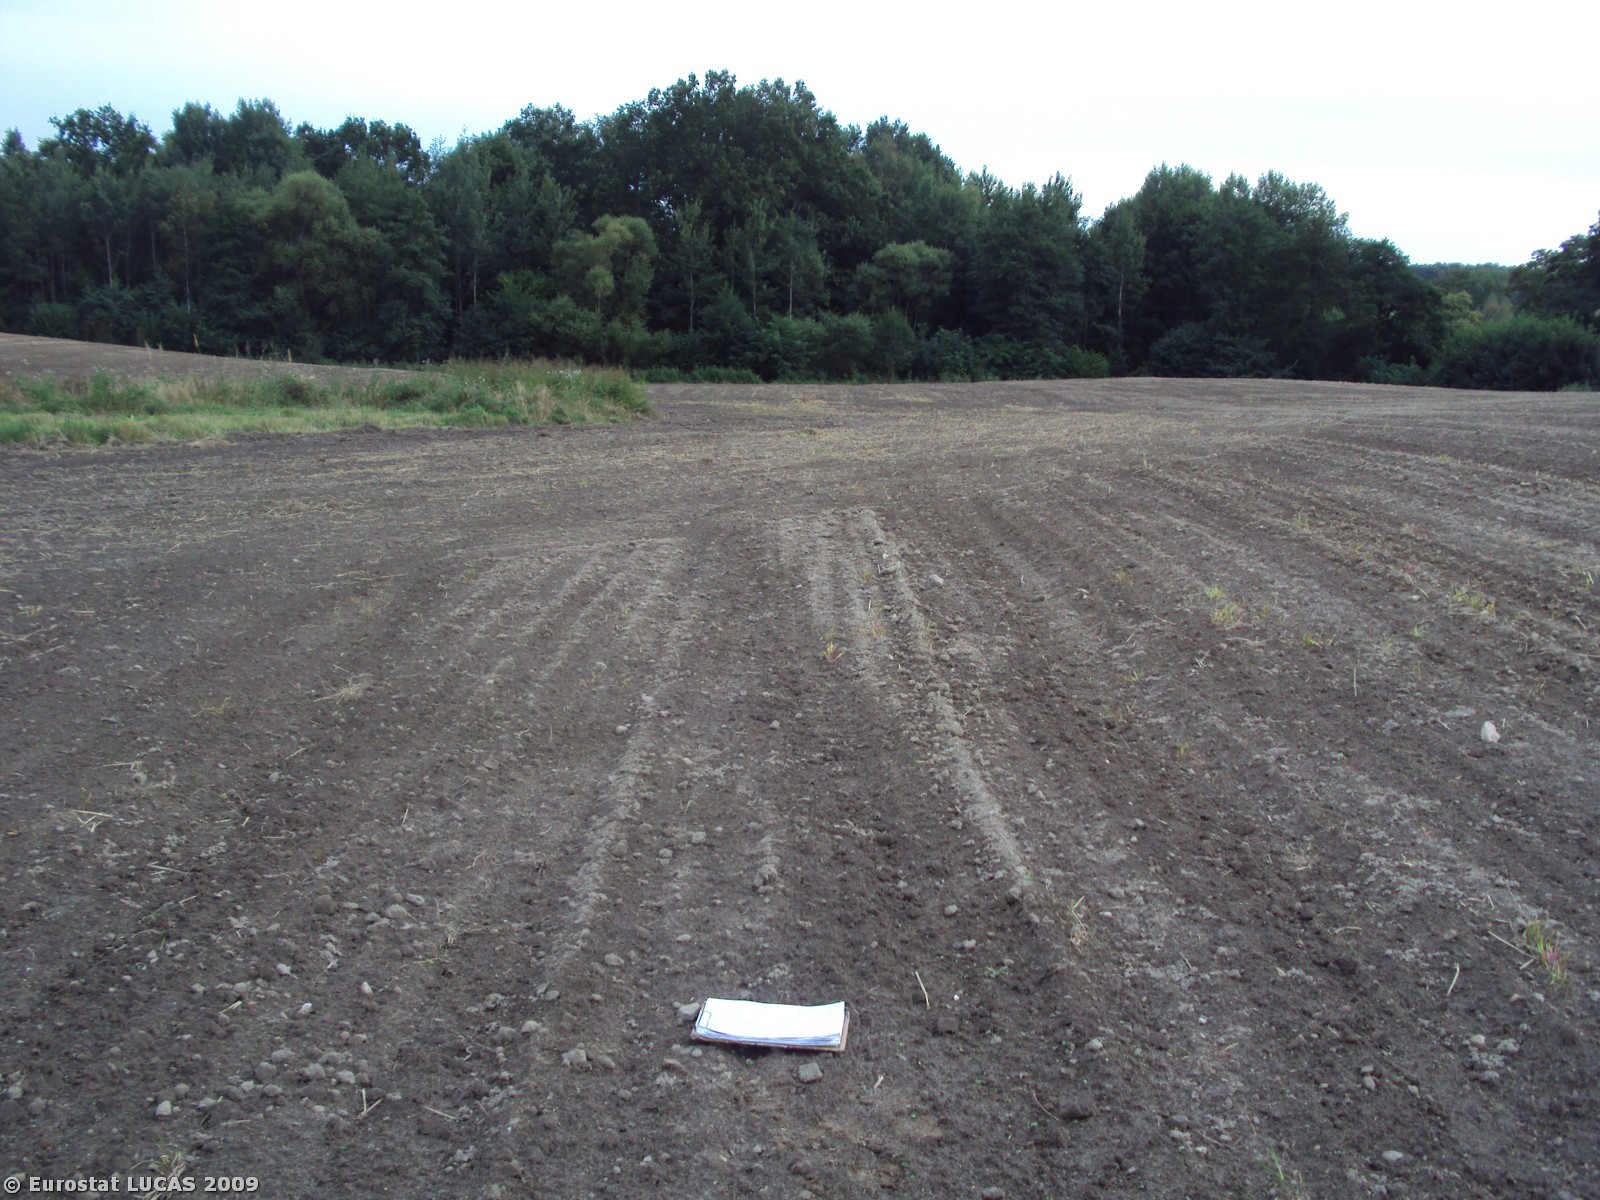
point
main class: Cropland
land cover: Common wheat
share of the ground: < 10 %
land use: Agriculture (excluding fallow land and kitchen gardens)
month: September
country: PL
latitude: 53.7040
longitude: 16.3532
